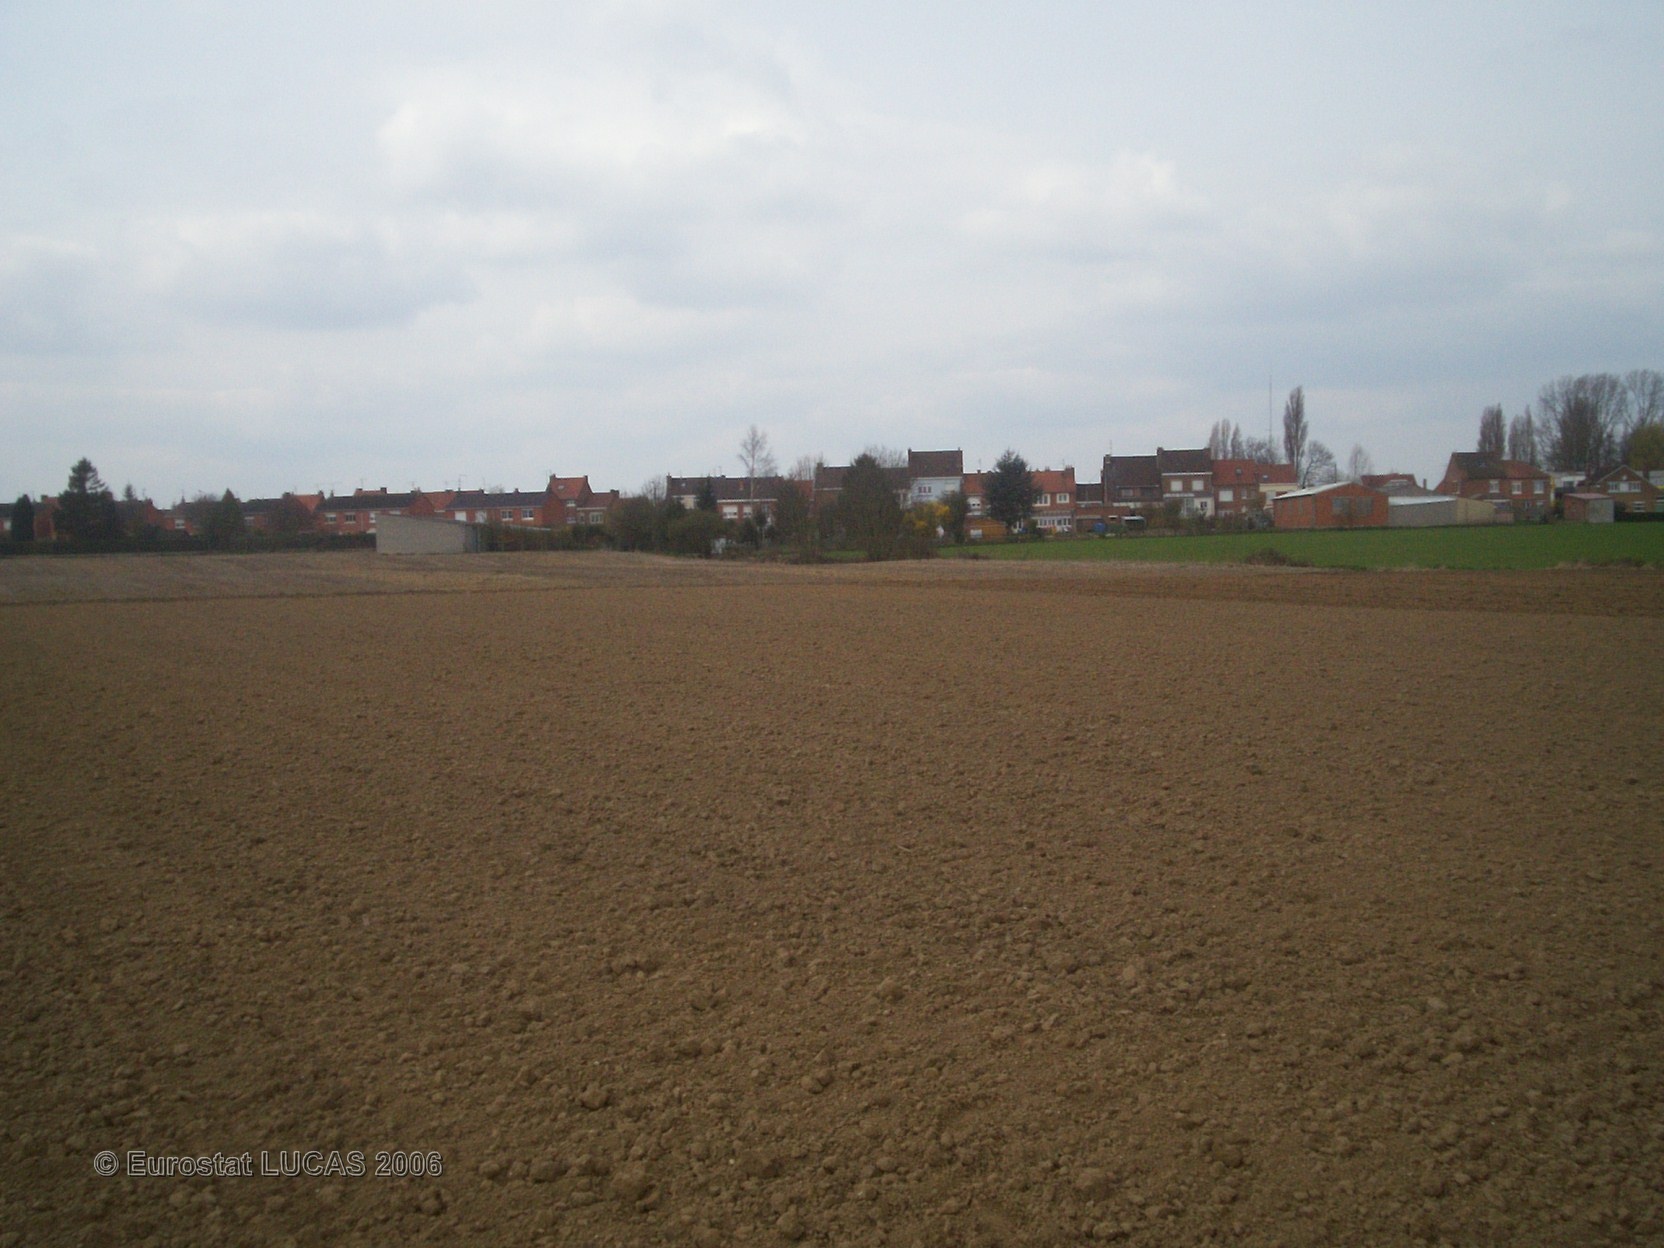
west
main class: Cropland
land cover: Maize
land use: Agriculture (excluding fallow land and kitchen gardens)
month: May
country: FR
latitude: 50.7349
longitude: 2.5489
